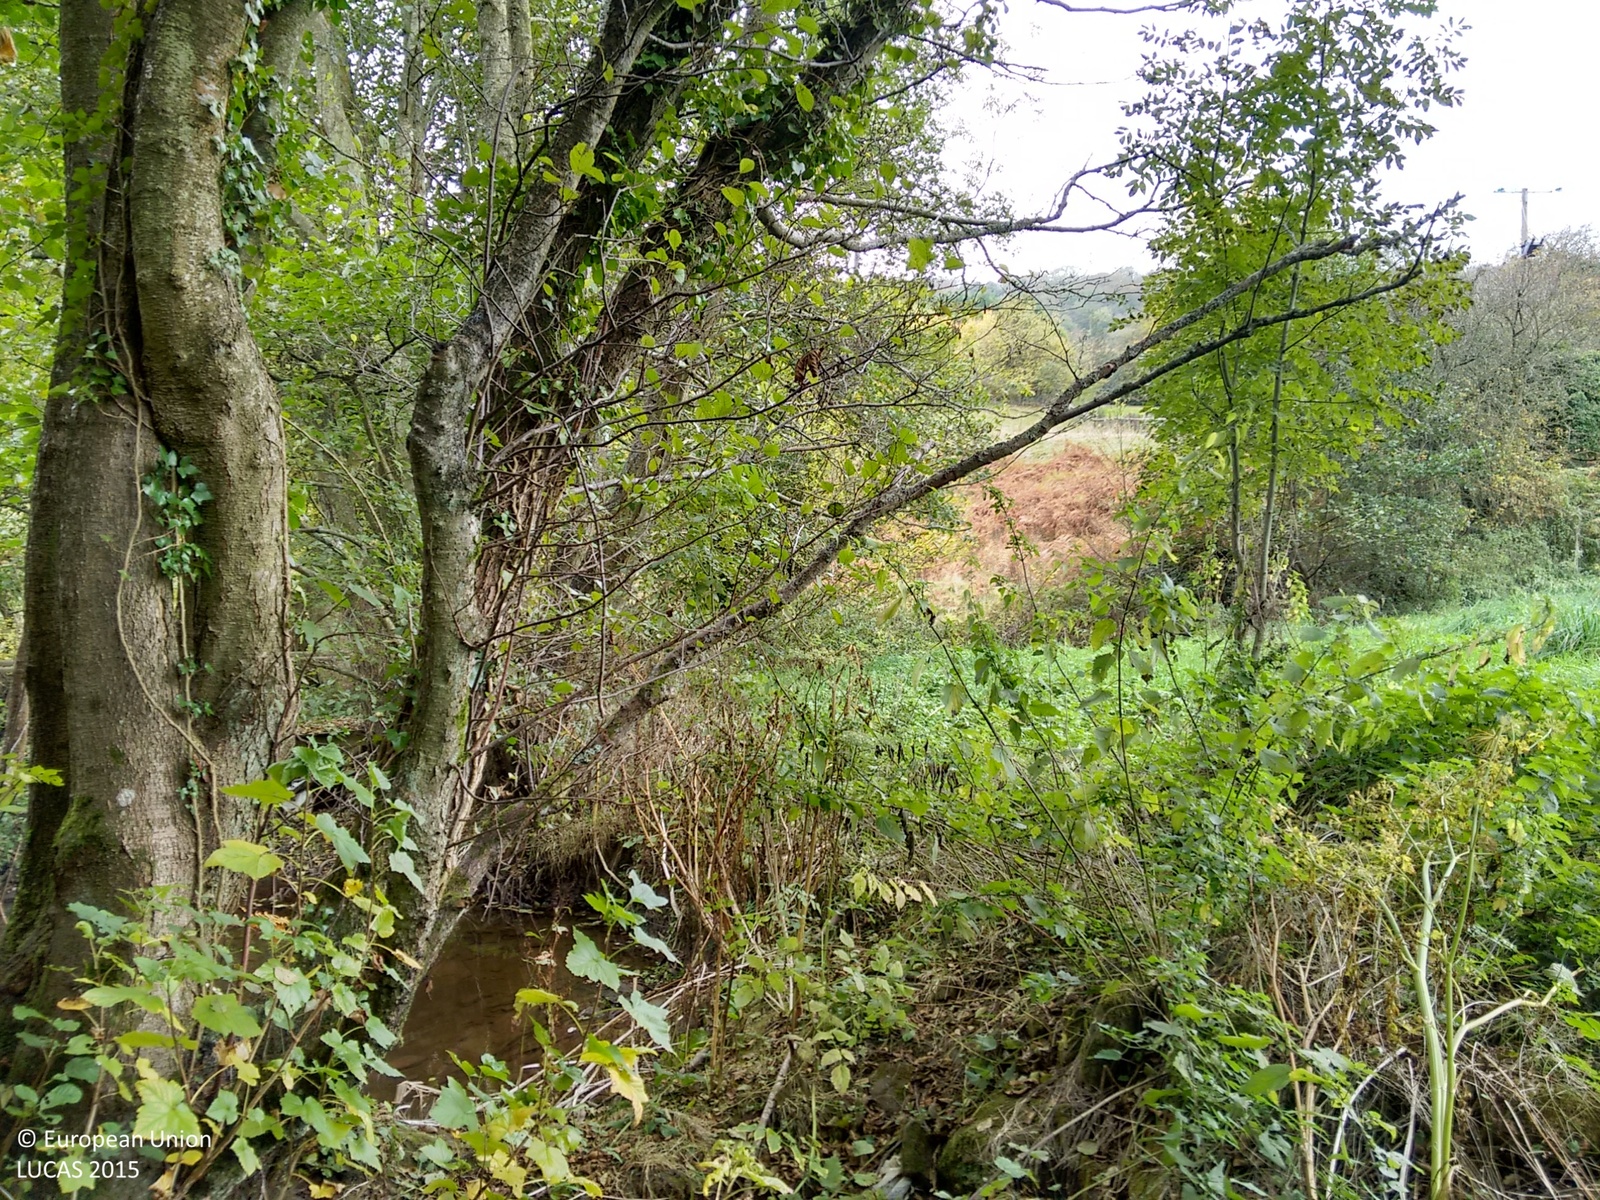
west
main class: Woodland
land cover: Broadleaved woodland
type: mesophytic deciduous forest
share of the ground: > 75 %
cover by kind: broadleaved forest trees 80 %, shrubs 10 %, herbaceous plants 10 %
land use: Semi-natural and natural areas not in use
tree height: > 5 m
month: October
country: GB
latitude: 51.7688
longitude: -2.6620
